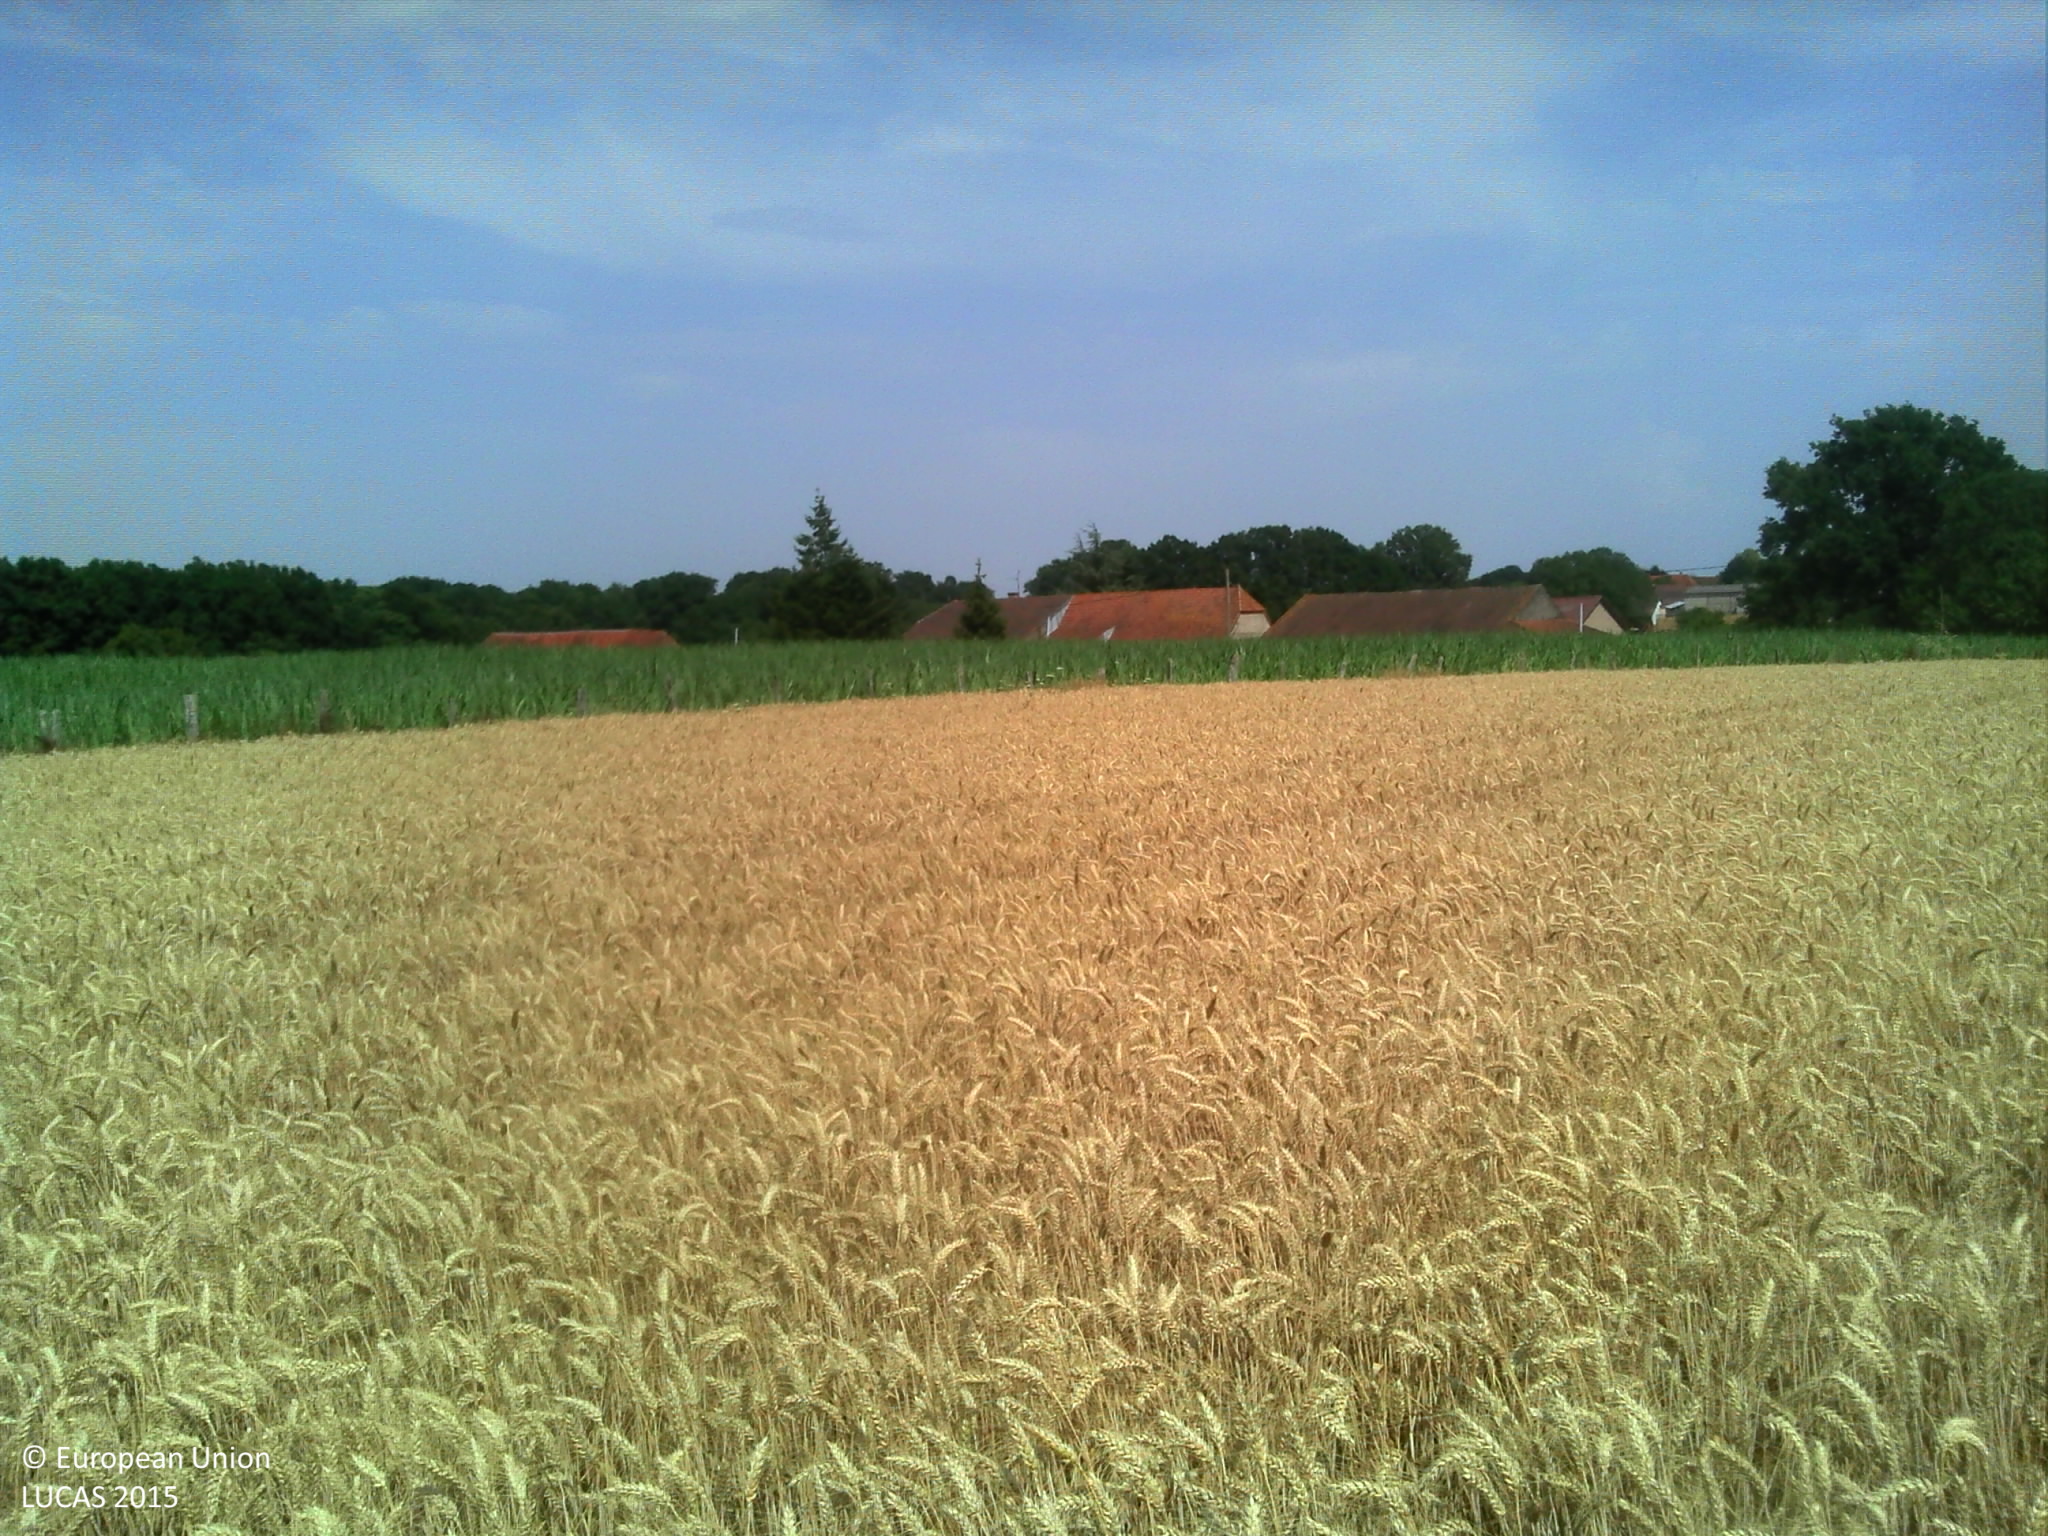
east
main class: Cropland
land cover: Barley
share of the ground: > 75 %
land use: Agriculture (excluding fallow land and kitchen gardens)
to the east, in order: Barley; Maize; Electric lines; Grass margins; Paved roads, cycling and walking lanes; Grass margins; Artificial constructions in urban areas; Grassland without tree/shrub cover; Fences; Grass margins; Paved roads, cycling and walking lanes
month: July
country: FR
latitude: 46.8250
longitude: 5.2959
